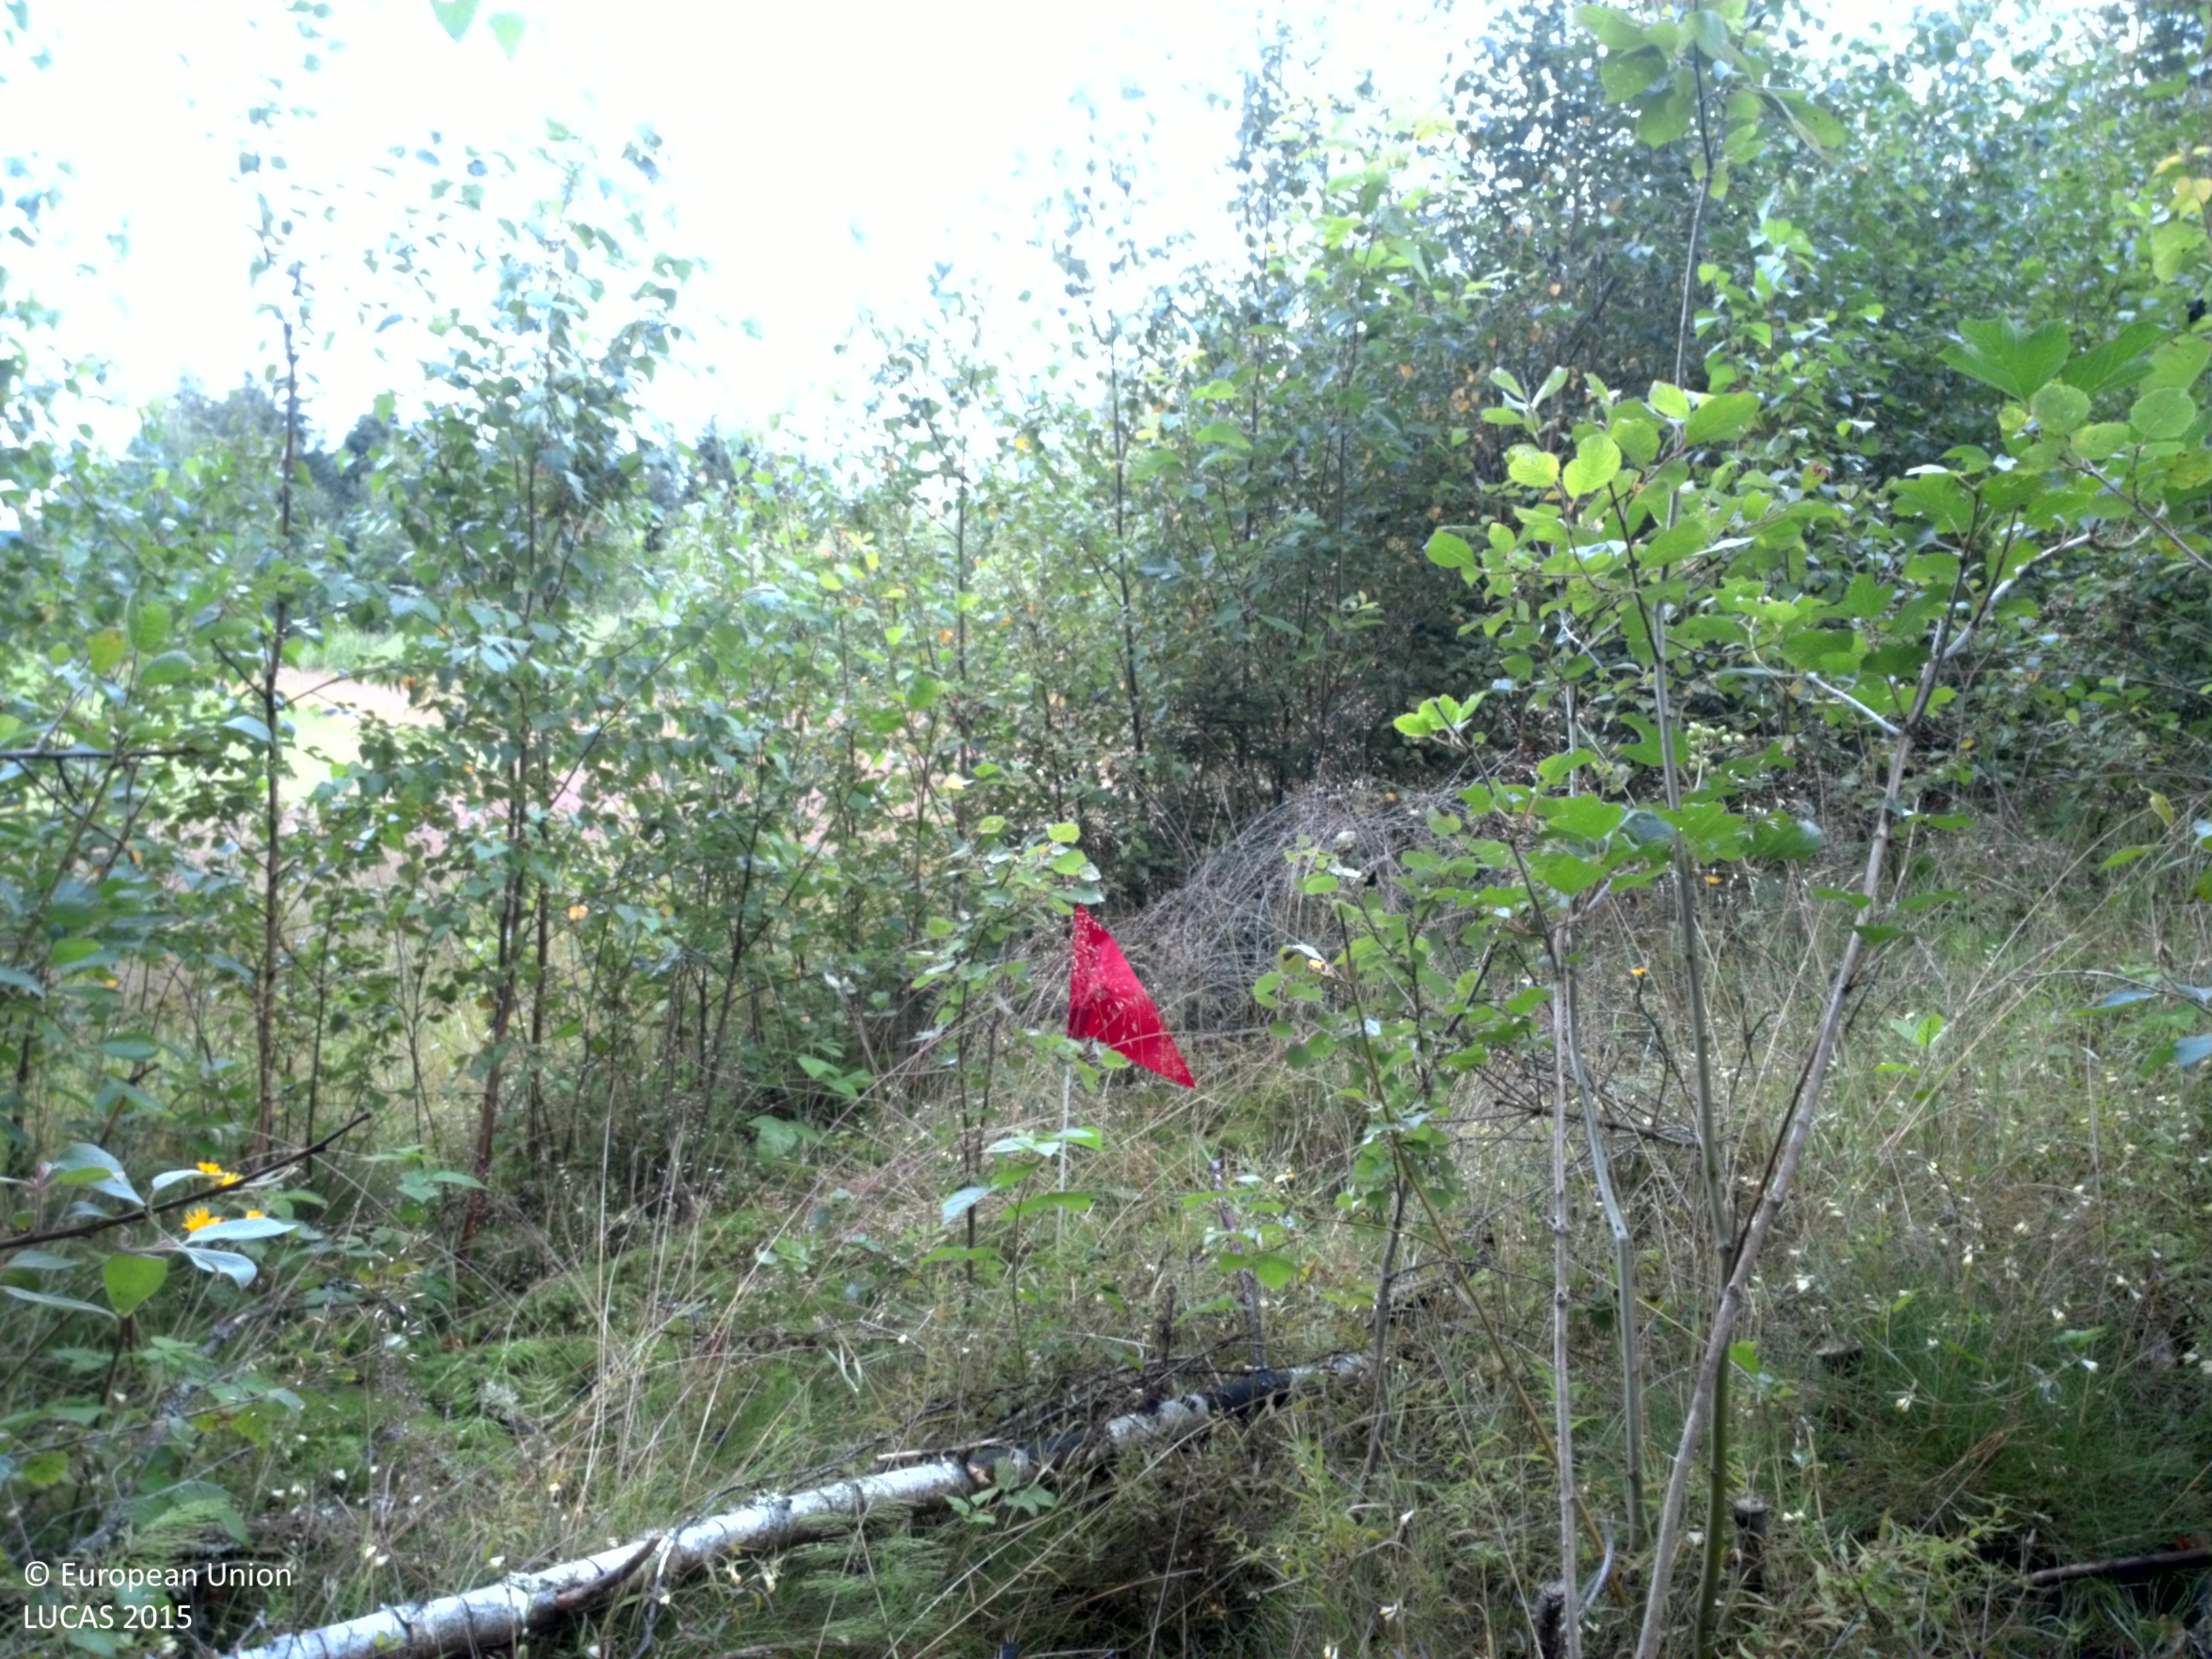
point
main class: Artificial land
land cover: Other artificial areas
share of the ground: 50 - 75 %
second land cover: Shrubland with sparse tree cover
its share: 50 - 75 %
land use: Electricity, gas and thermal power distribution
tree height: < 5 m
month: August
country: SE
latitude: 59.5843
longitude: 13.2681
